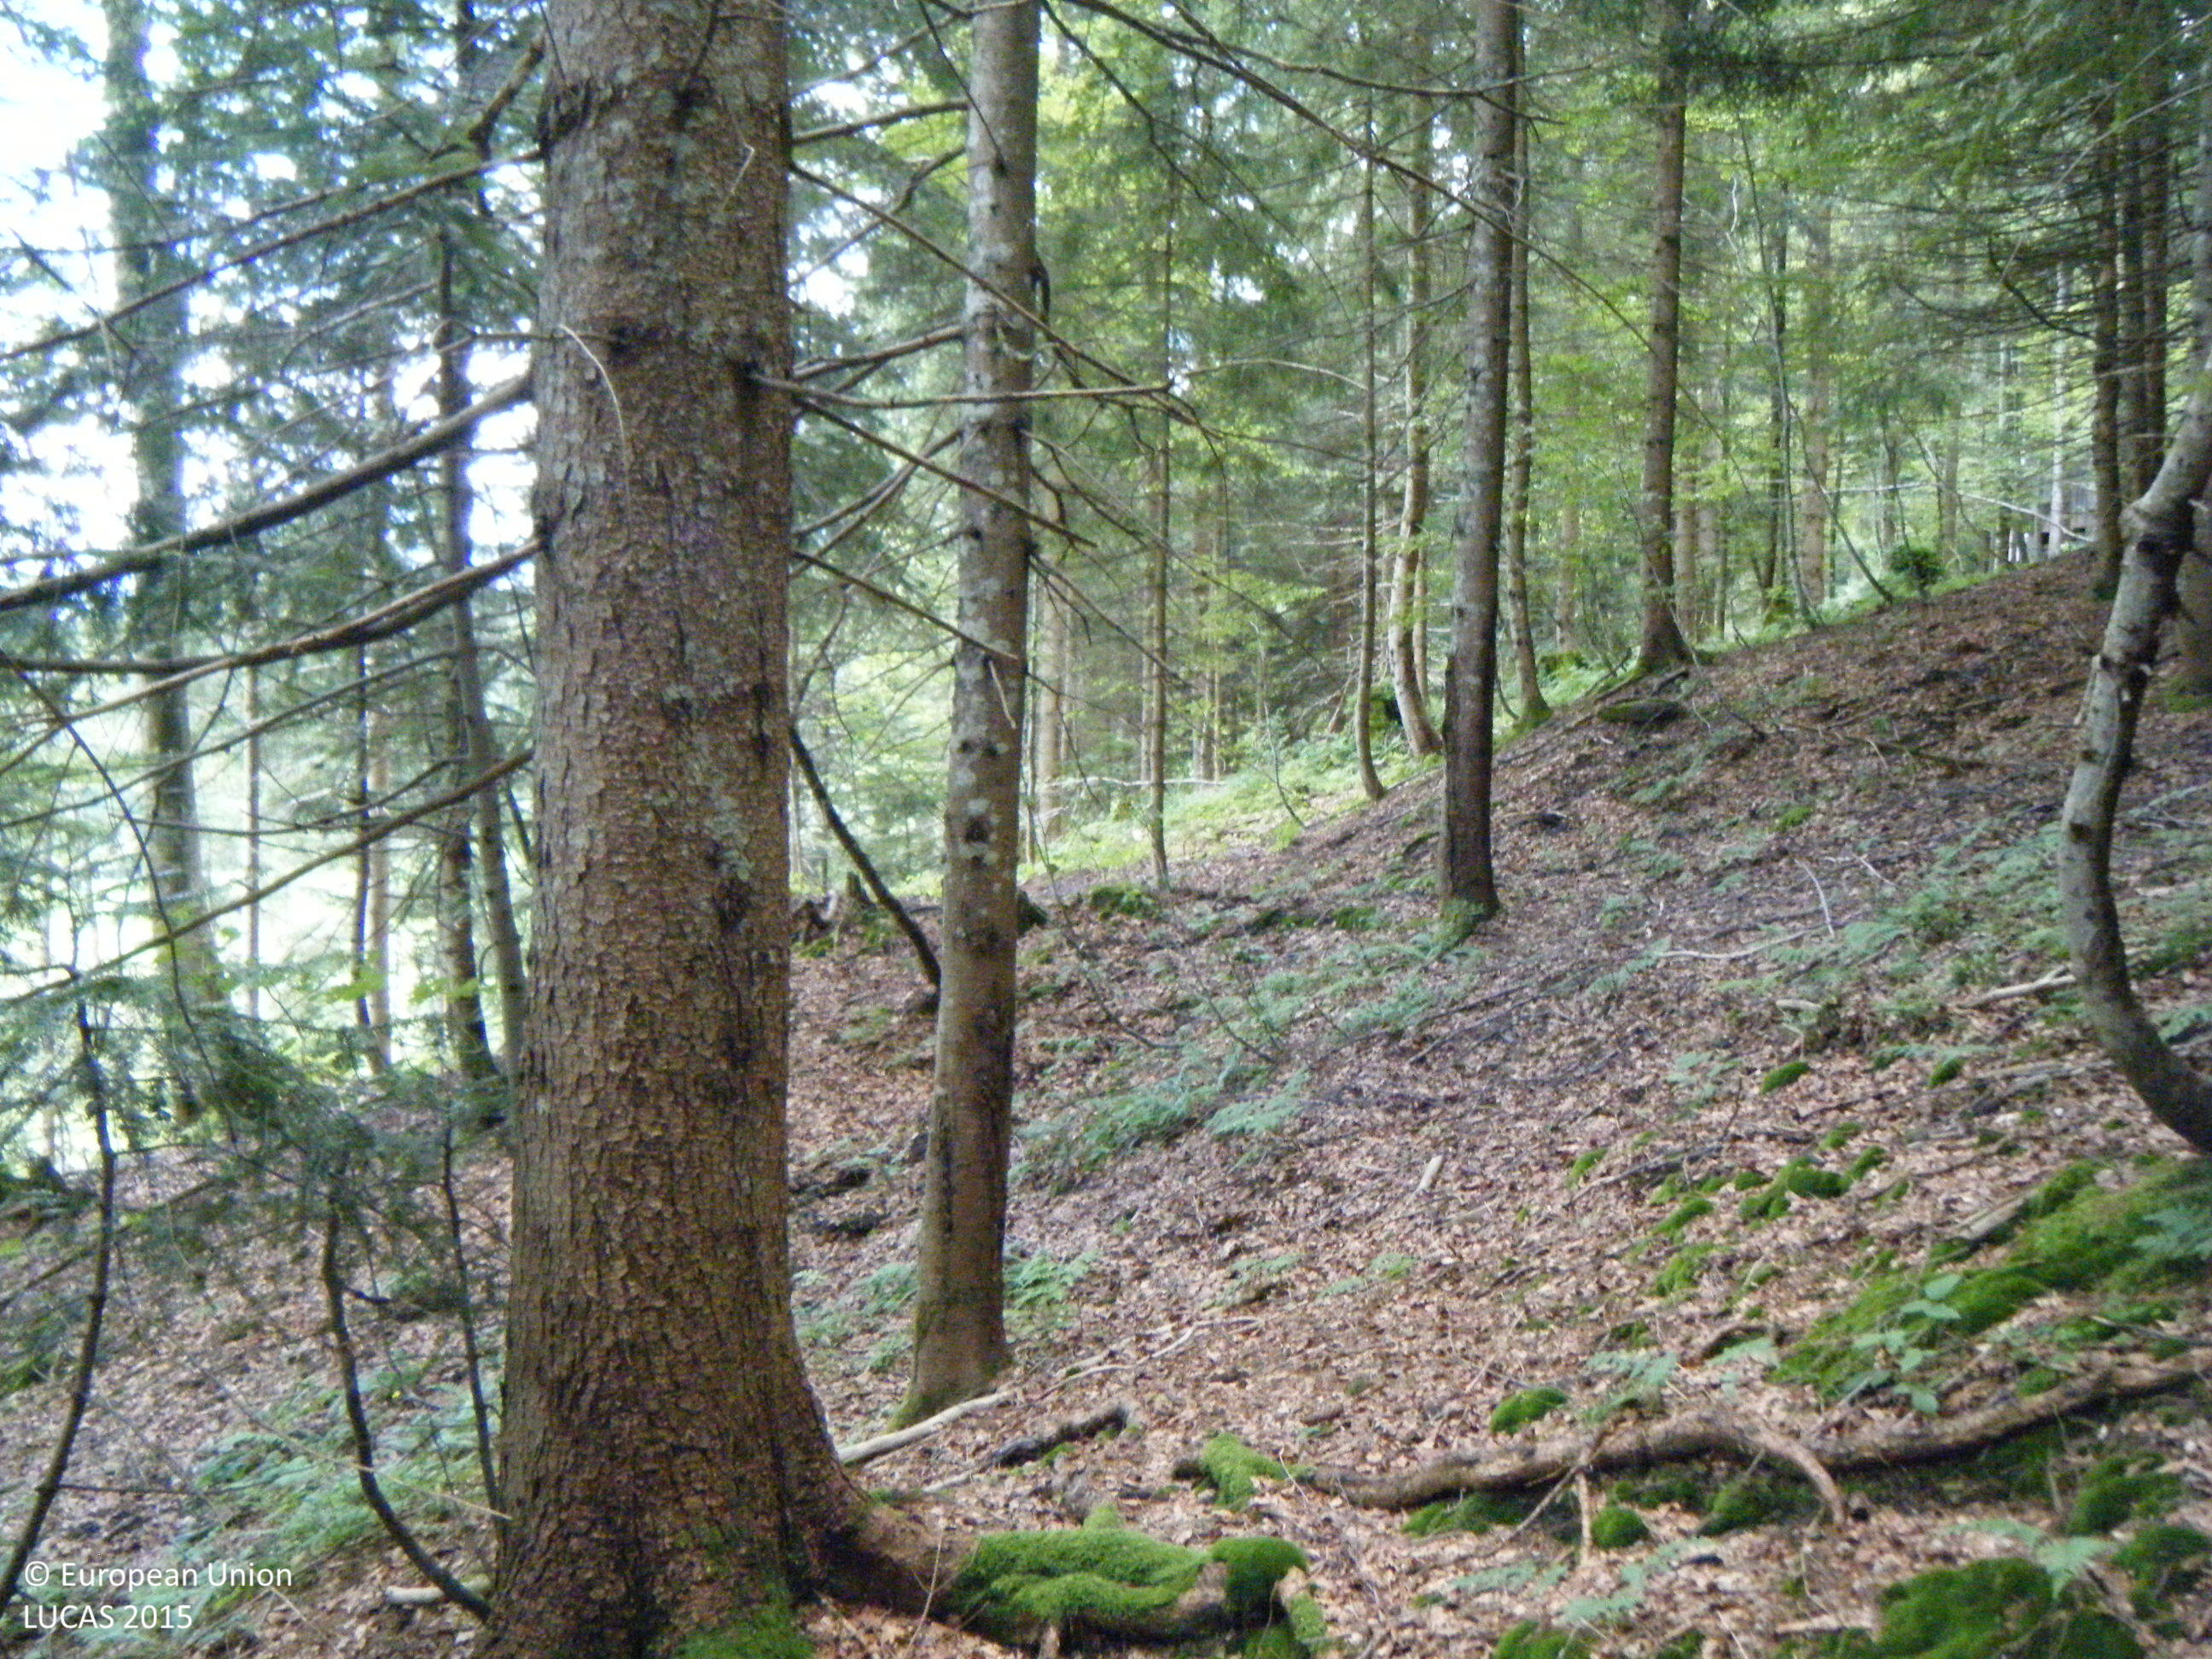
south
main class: Woodland
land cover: Other mixed woodland
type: alpine coniferous forest
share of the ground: > 75 %
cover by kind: coniferous forest trees 65 %, broadleaved forest trees 25 %, herbaceous plants 5 %, unconsolidated bare surface 5 %
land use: Forestry
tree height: > 5 m
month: July
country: AT
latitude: 47.6737
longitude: 13.7414
